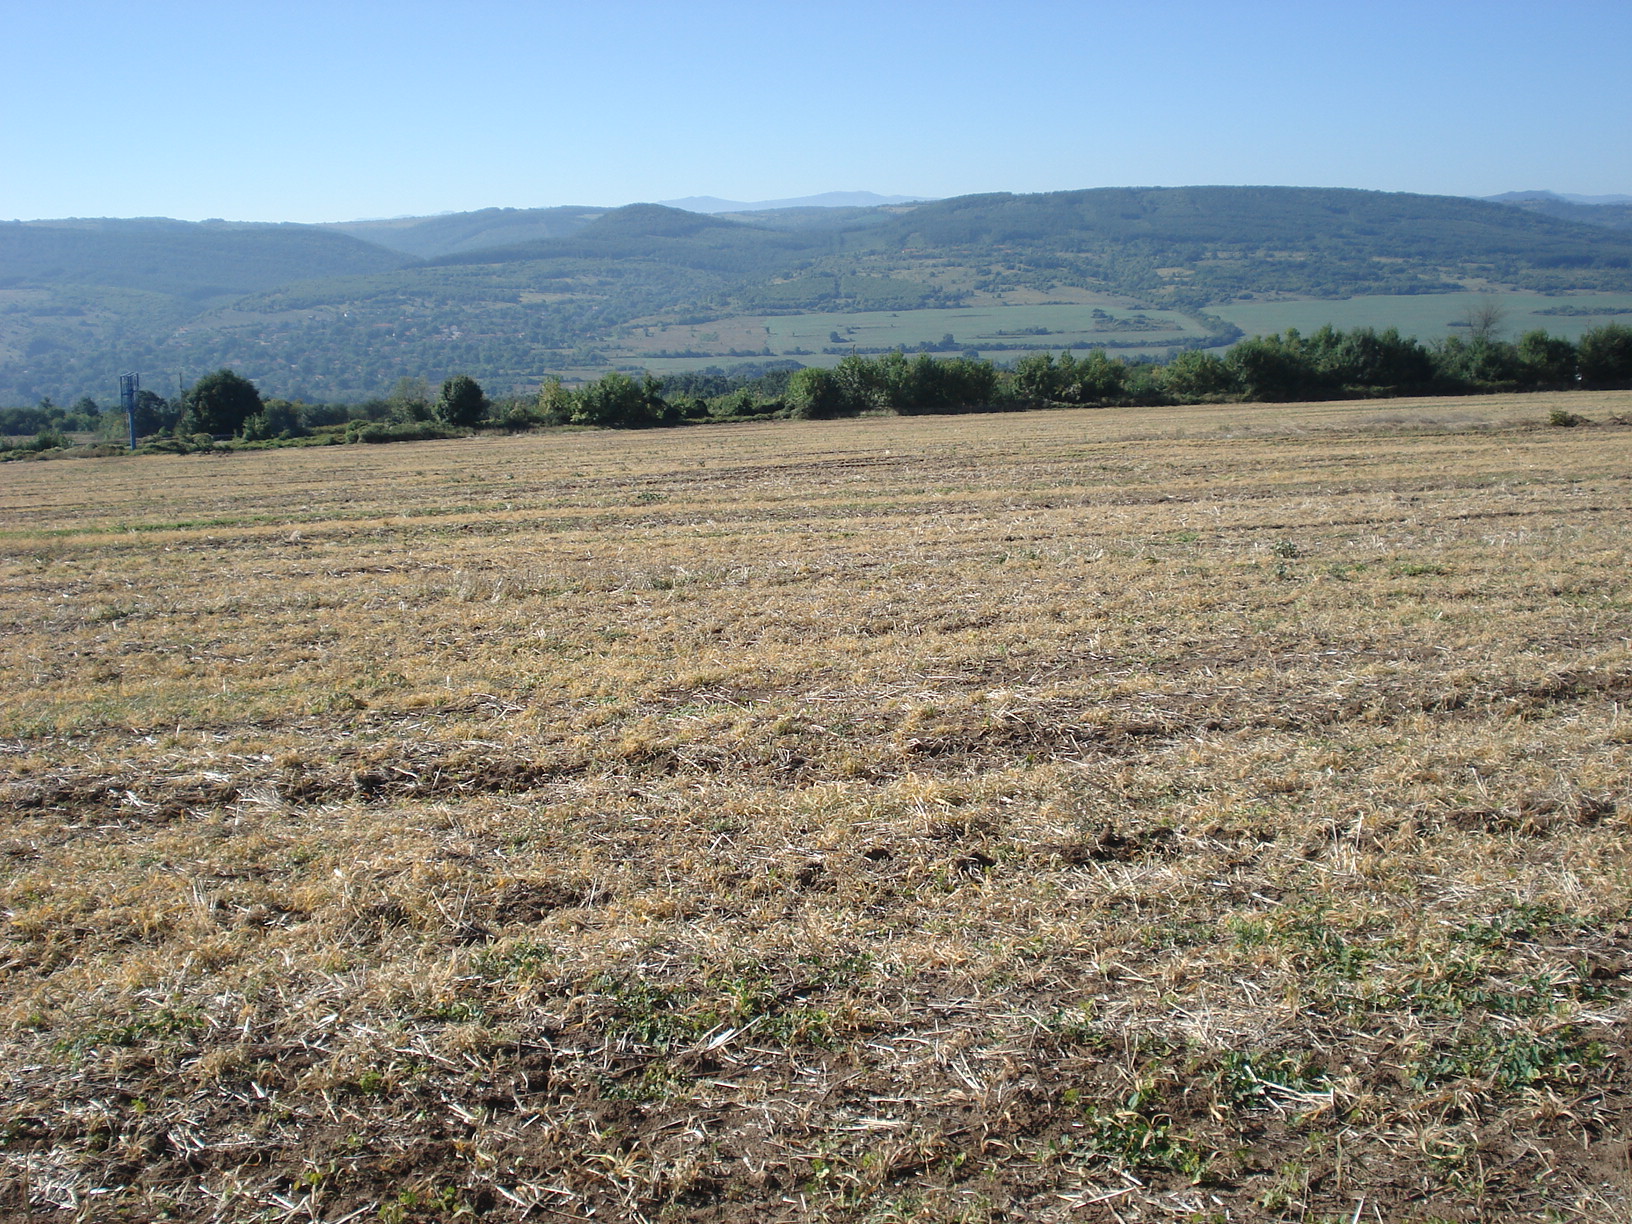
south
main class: Cropland
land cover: Common wheat
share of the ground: 10 - 25 %
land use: Agriculture (excluding fallow land and kitchen gardens)
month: September
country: BG
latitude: 43.0904
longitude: 25.4692
